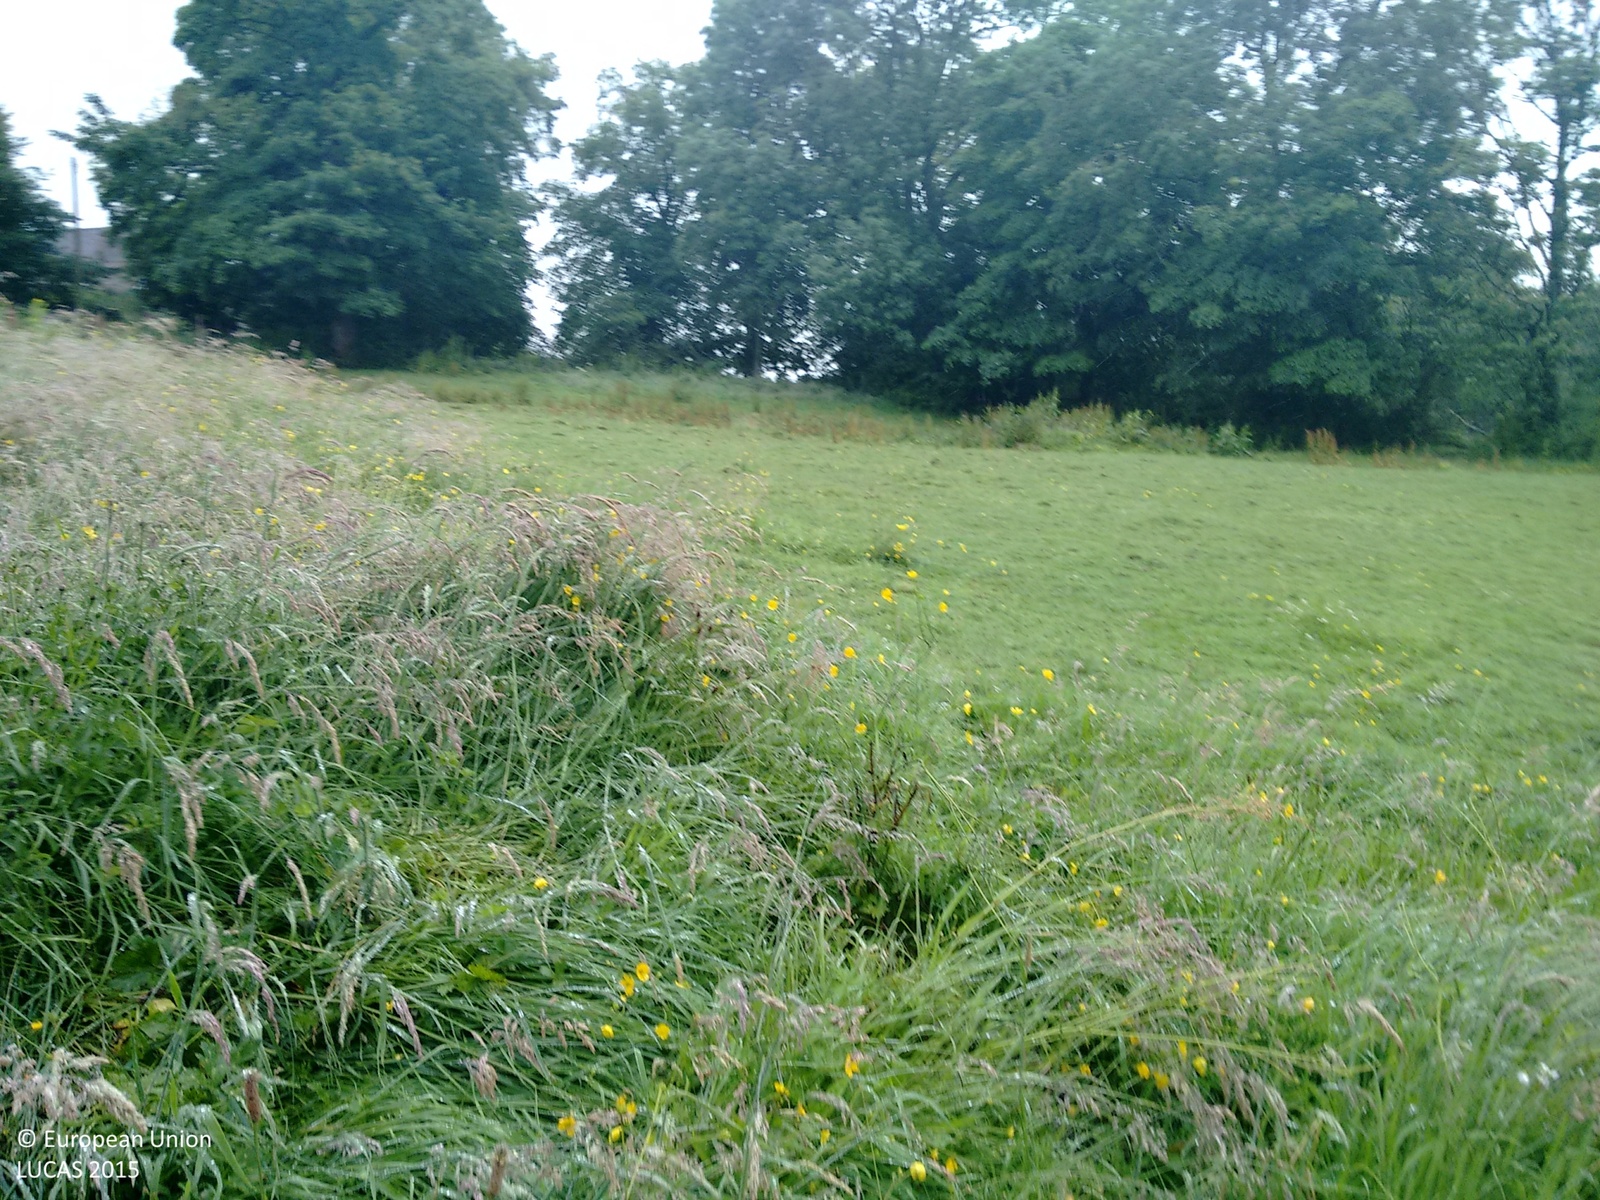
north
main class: Grassland
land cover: Grassland without tree/shrub cover
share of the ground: > 75 %
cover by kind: herbaceous plants 100 %
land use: Agriculture (excluding fallow land and kitchen gardens)
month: July
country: GB
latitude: 53.1447
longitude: -2.0338
